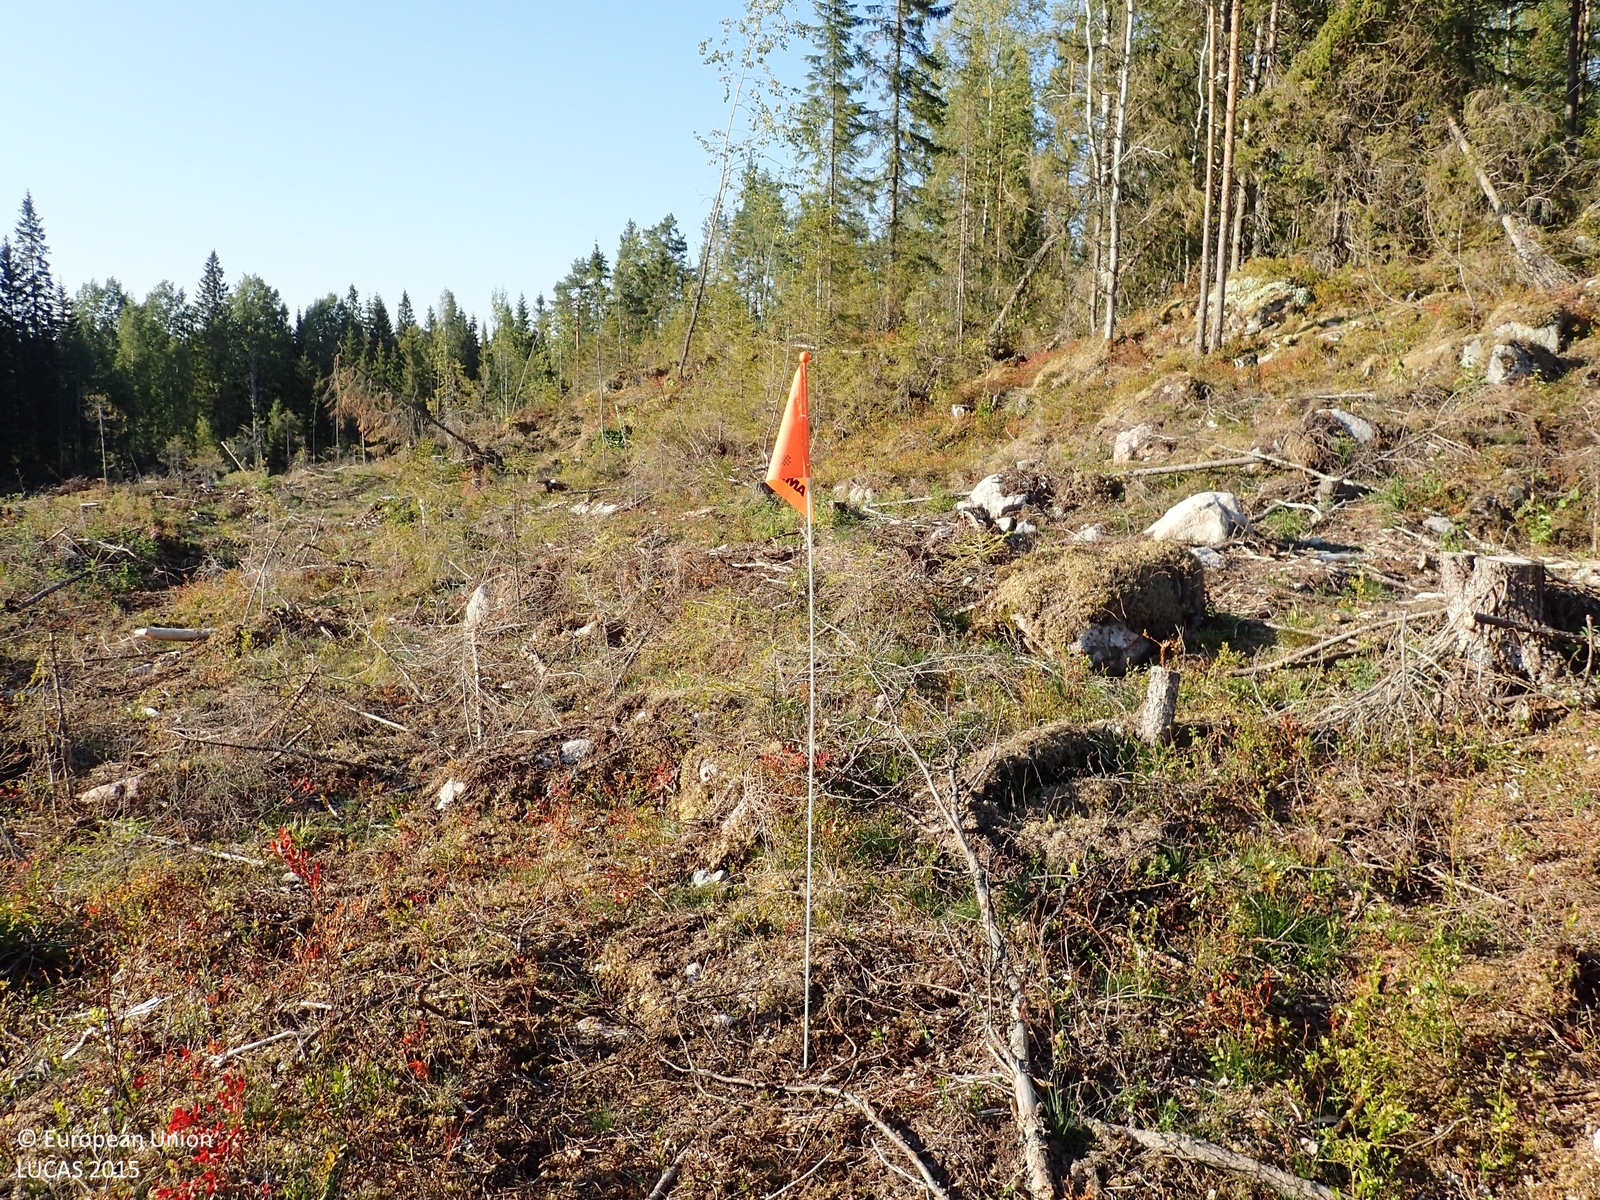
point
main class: Shrubland
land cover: Shrubland with sparse tree cover
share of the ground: 10 - 25 %
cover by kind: unconsolidated bare surface 40 %, lichens and mosses 20 %, shrubs 15 %, herbaceous plants 15 %, coniferous forest trees 5 %, consolidated bare surface 5 %
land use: Forestry
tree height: < 5 m
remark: Clear cut
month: August
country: FI
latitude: 62.4324
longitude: 21.8826
